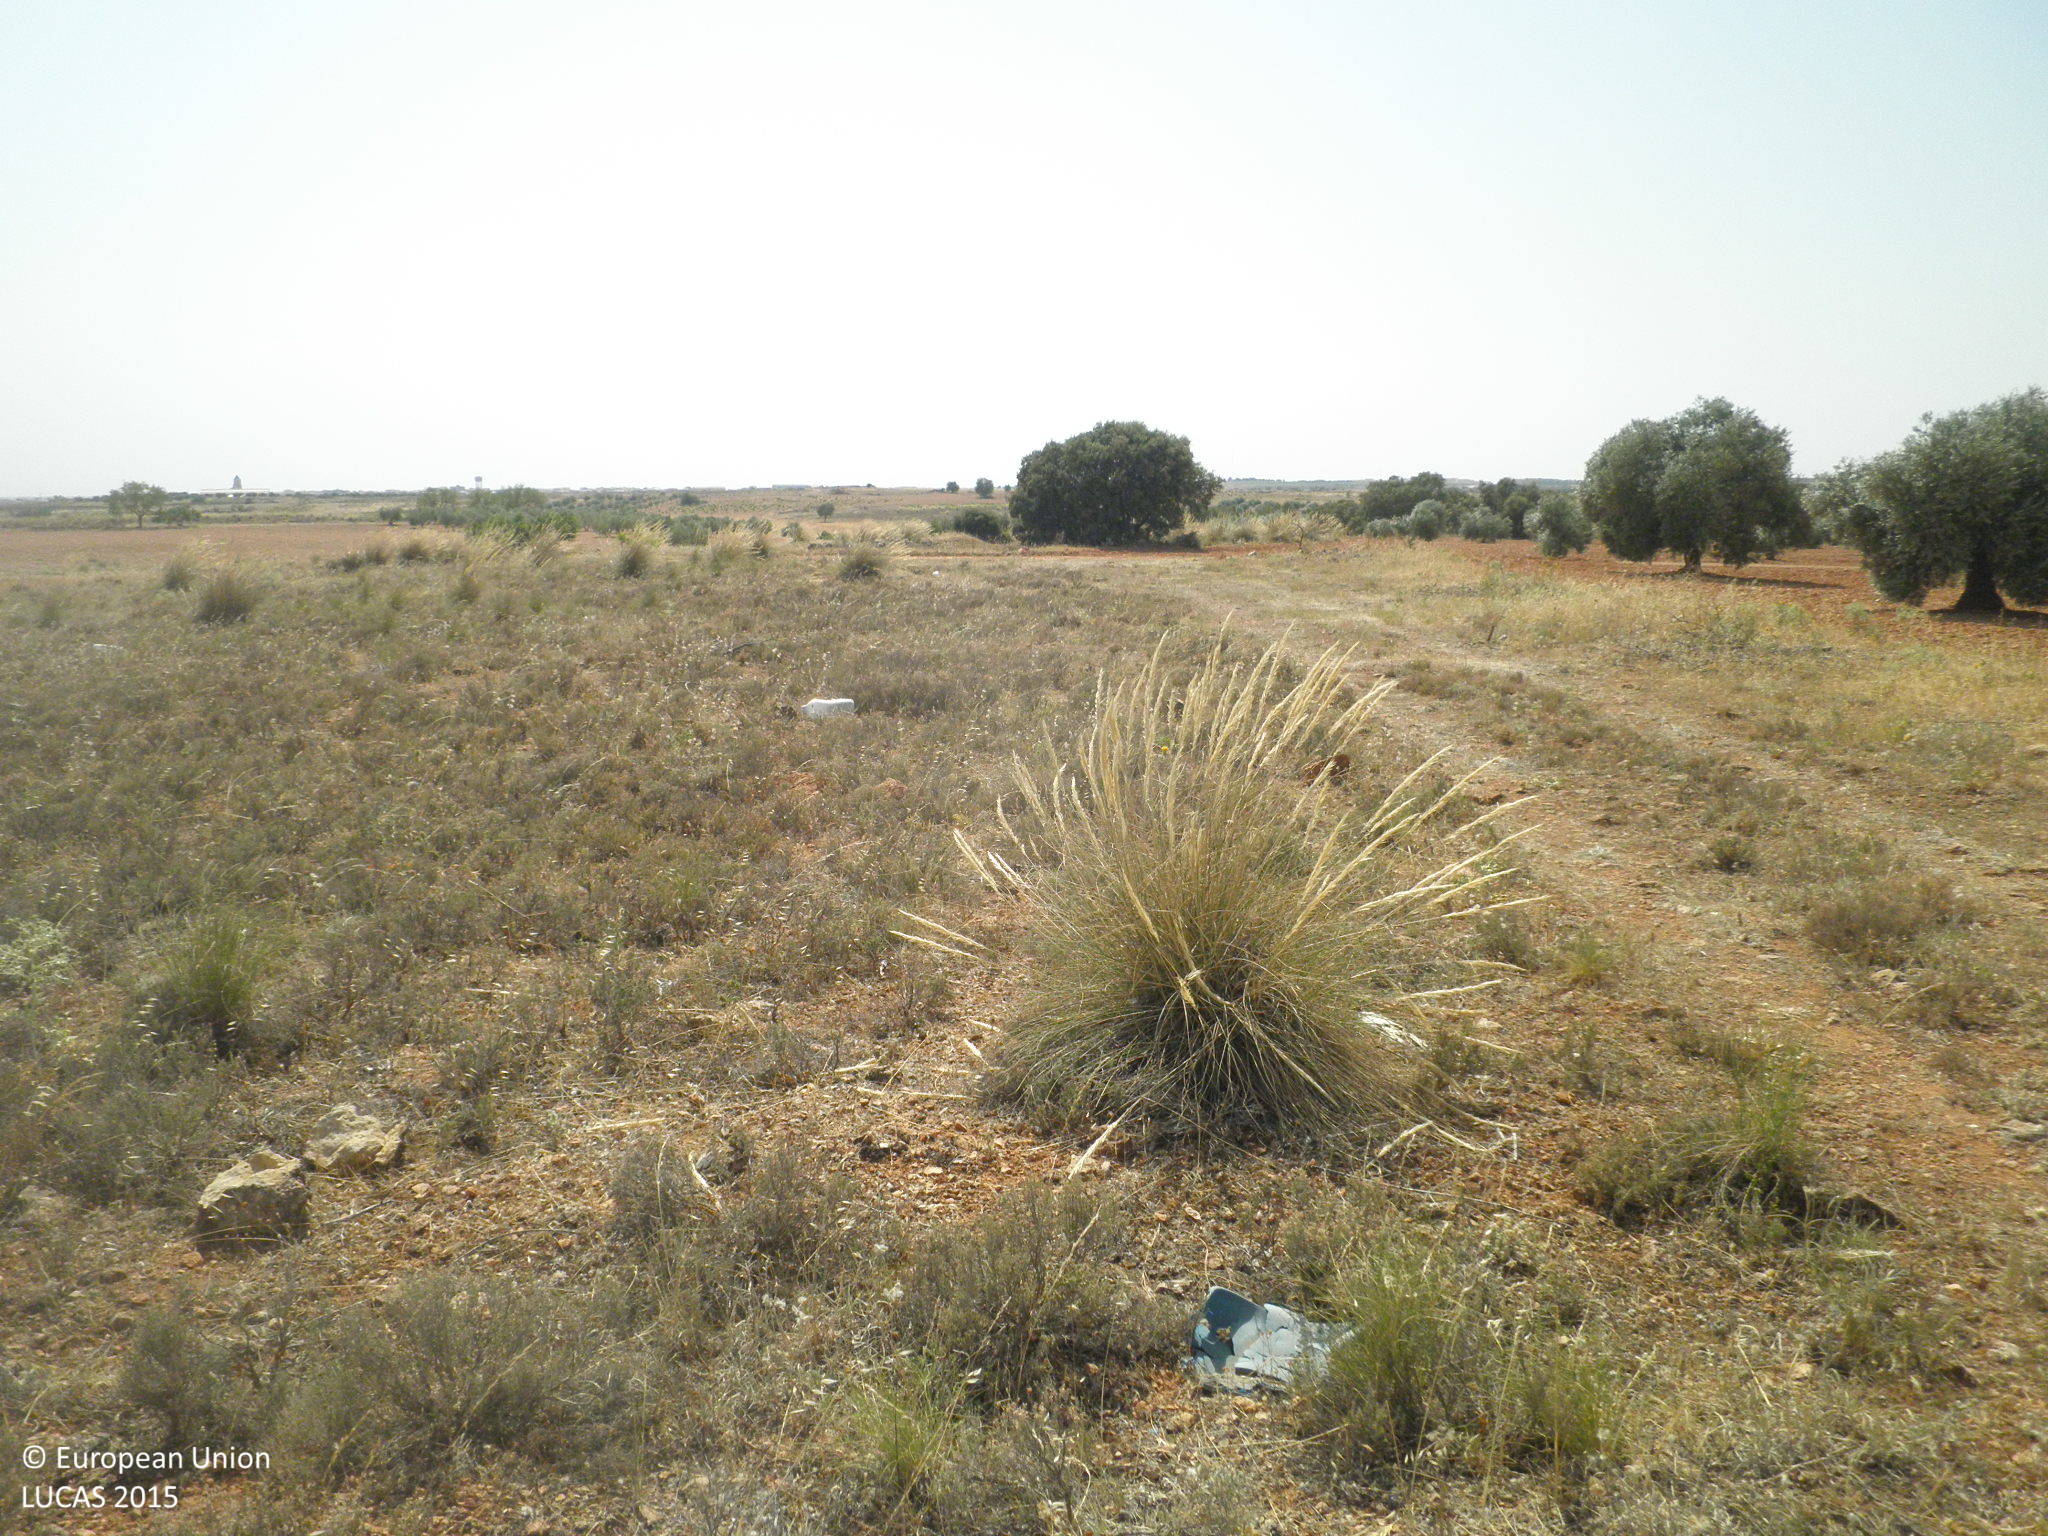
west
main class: Shrubland
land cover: Shrubland without tree cover
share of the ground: 25 - 50 %
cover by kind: unconsolidated bare surface 50 %, shrubs 30 %, herbaceous plants 20 %
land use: Abandoned areas
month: July
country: ES
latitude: 39.4636
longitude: -2.6471
